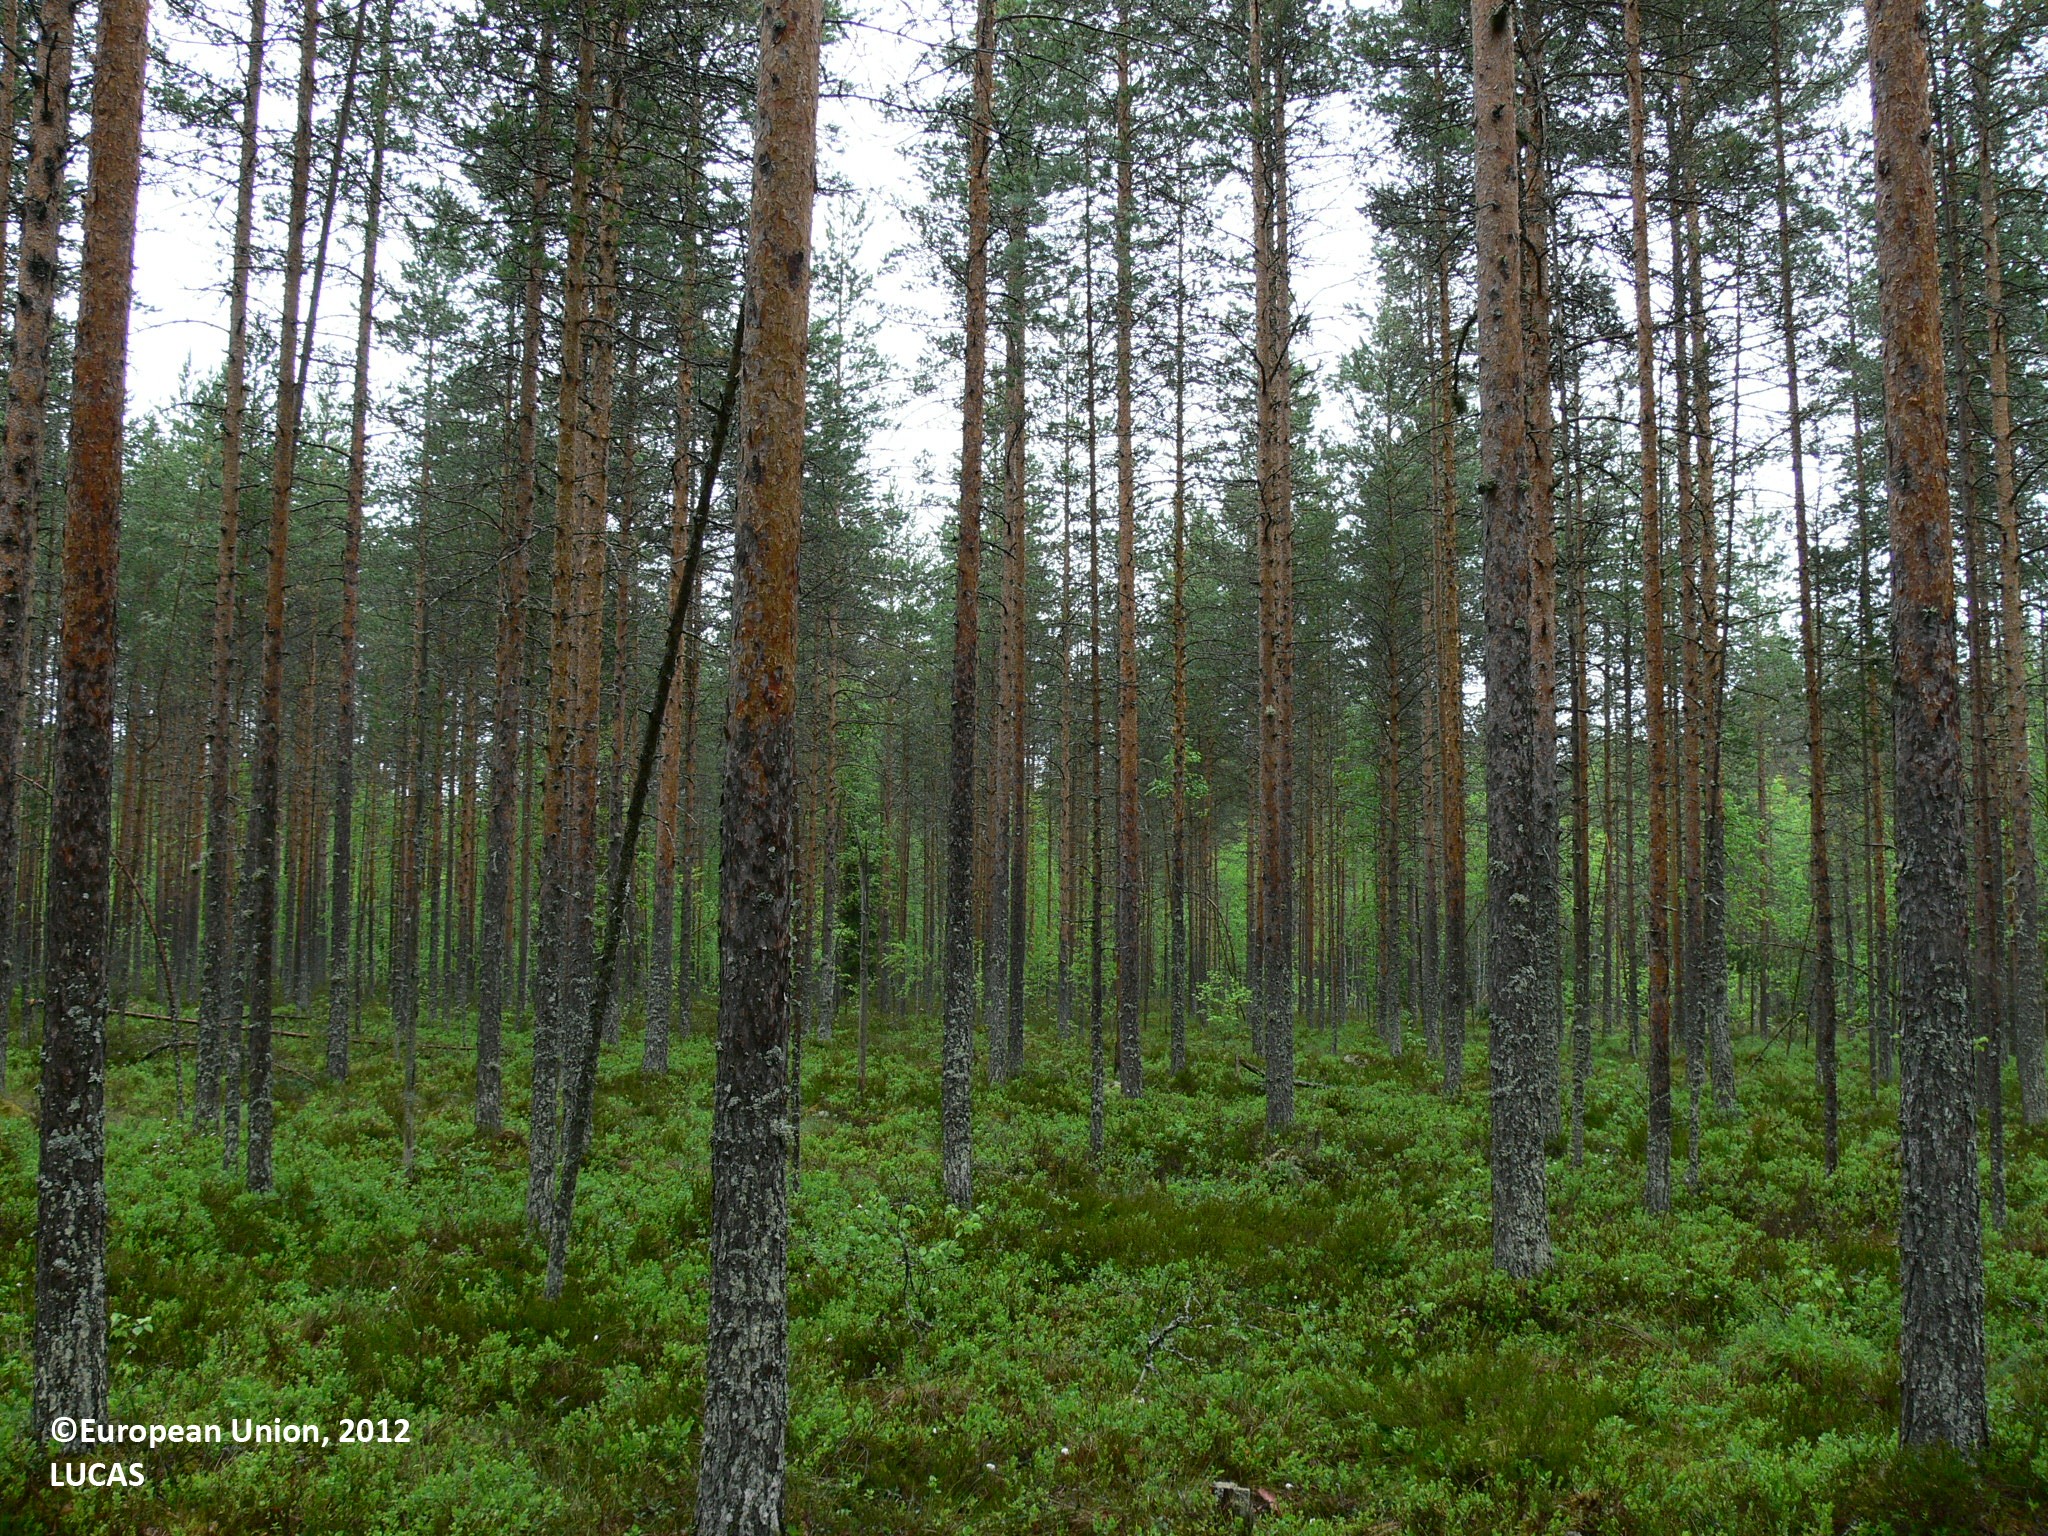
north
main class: Woodland
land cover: Pine dominated coniferous woodland
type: boreal forest
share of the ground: > 75 %
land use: Forestry
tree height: > 5 m
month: June
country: FI
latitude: 62.4873
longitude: 30.2380
